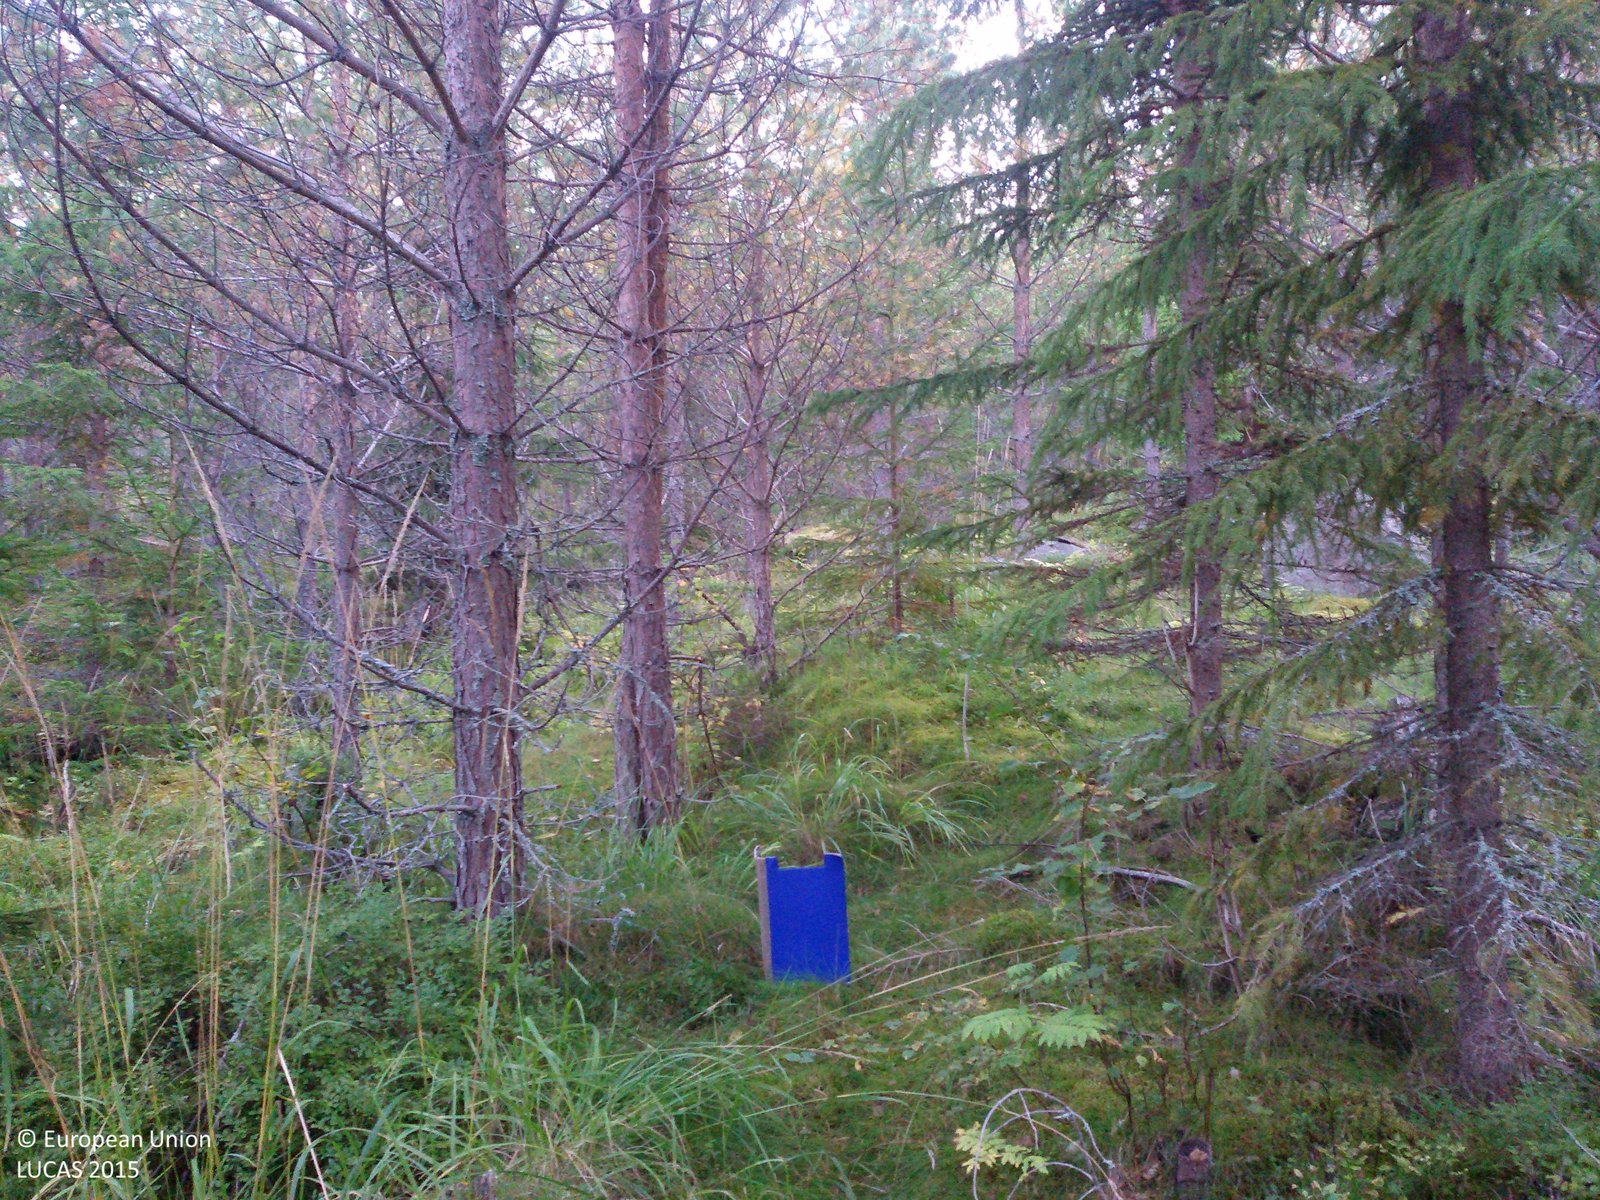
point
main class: Woodland
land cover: Pine dominated coniferous woodland
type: boreal forest
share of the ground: > 75 %
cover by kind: coniferous forest trees 80 %, shrubs 15 %, lichens and mosses 5 %
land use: Forestry
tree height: > 5 m
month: September
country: SE
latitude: 60.7158
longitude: 14.6975
